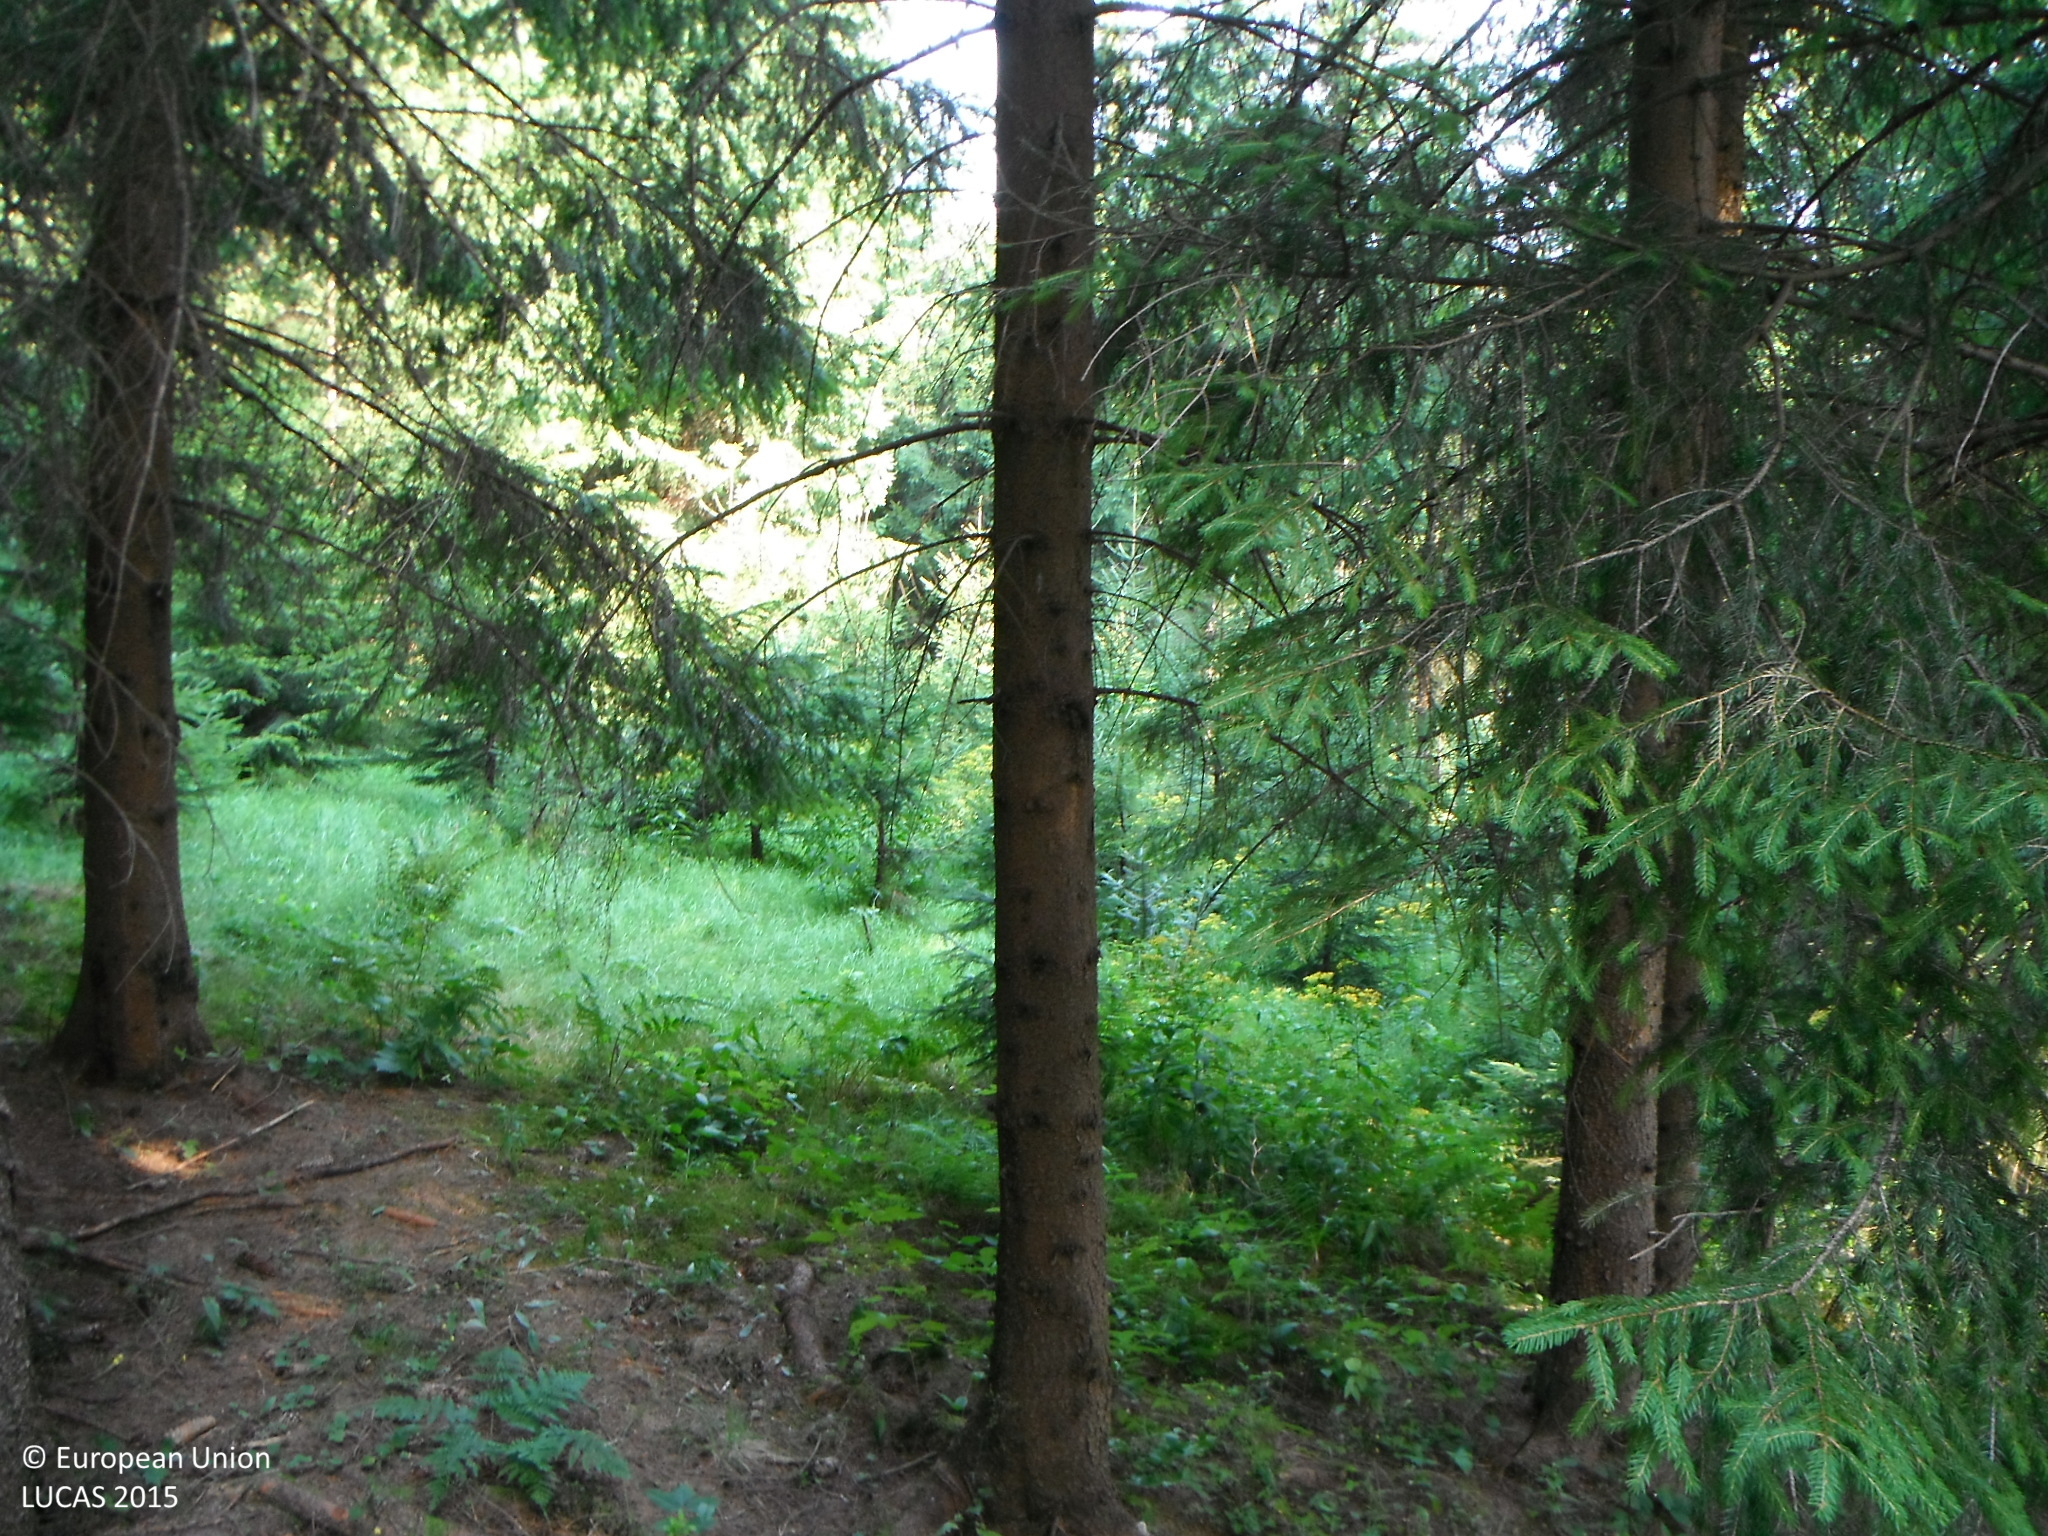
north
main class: Woodland
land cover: Spruce dominated coniferous woodland
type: alpine coniferous forest
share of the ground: > 75 %
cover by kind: coniferous forest trees 95 %, herbaceous plants 5 %
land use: Forestry
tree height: > 5 m
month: August
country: SK
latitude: 49.4741
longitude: 18.8953
